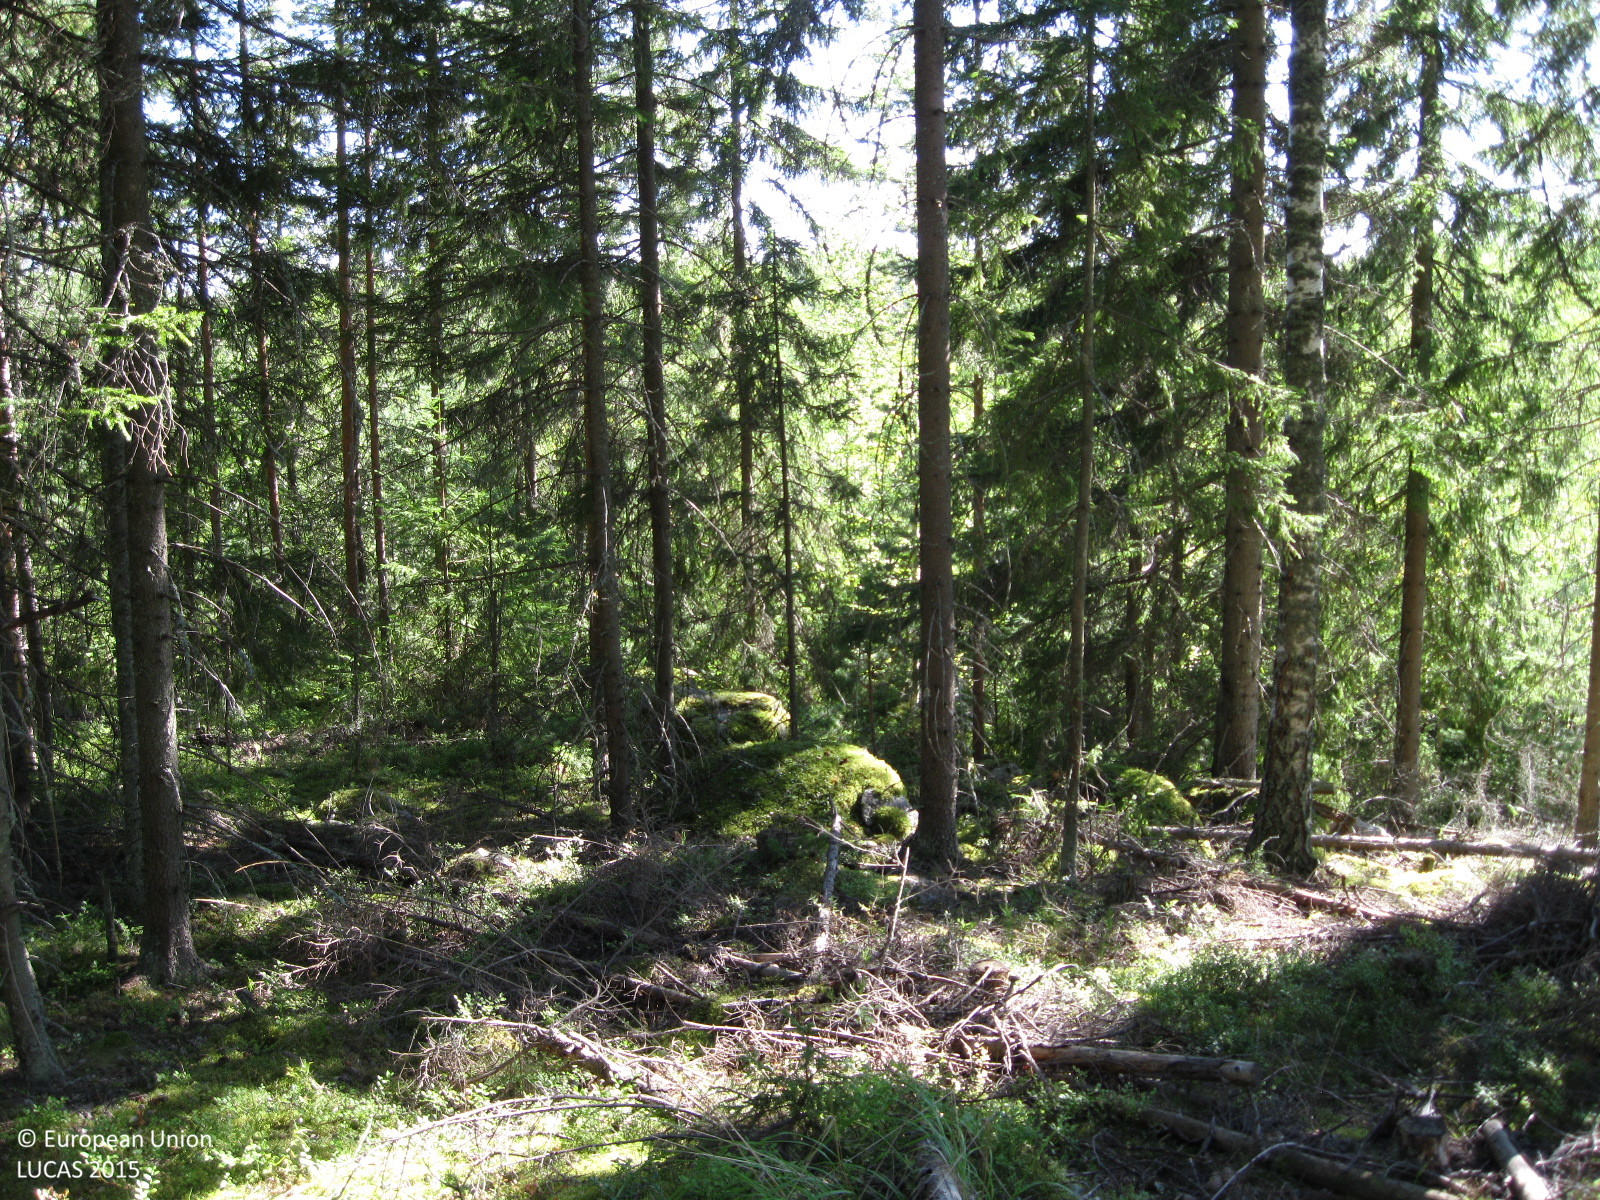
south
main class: Woodland
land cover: Spruce dominated coniferous woodland
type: boreal forest
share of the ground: > 75 %
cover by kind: coniferous forest trees 75 %, lichens and mosses 15 %, shrubs 5 %, herbaceous plants 5 %
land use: Forestry
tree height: > 5 m
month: August
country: FI
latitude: 61.4264
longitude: 25.3944
